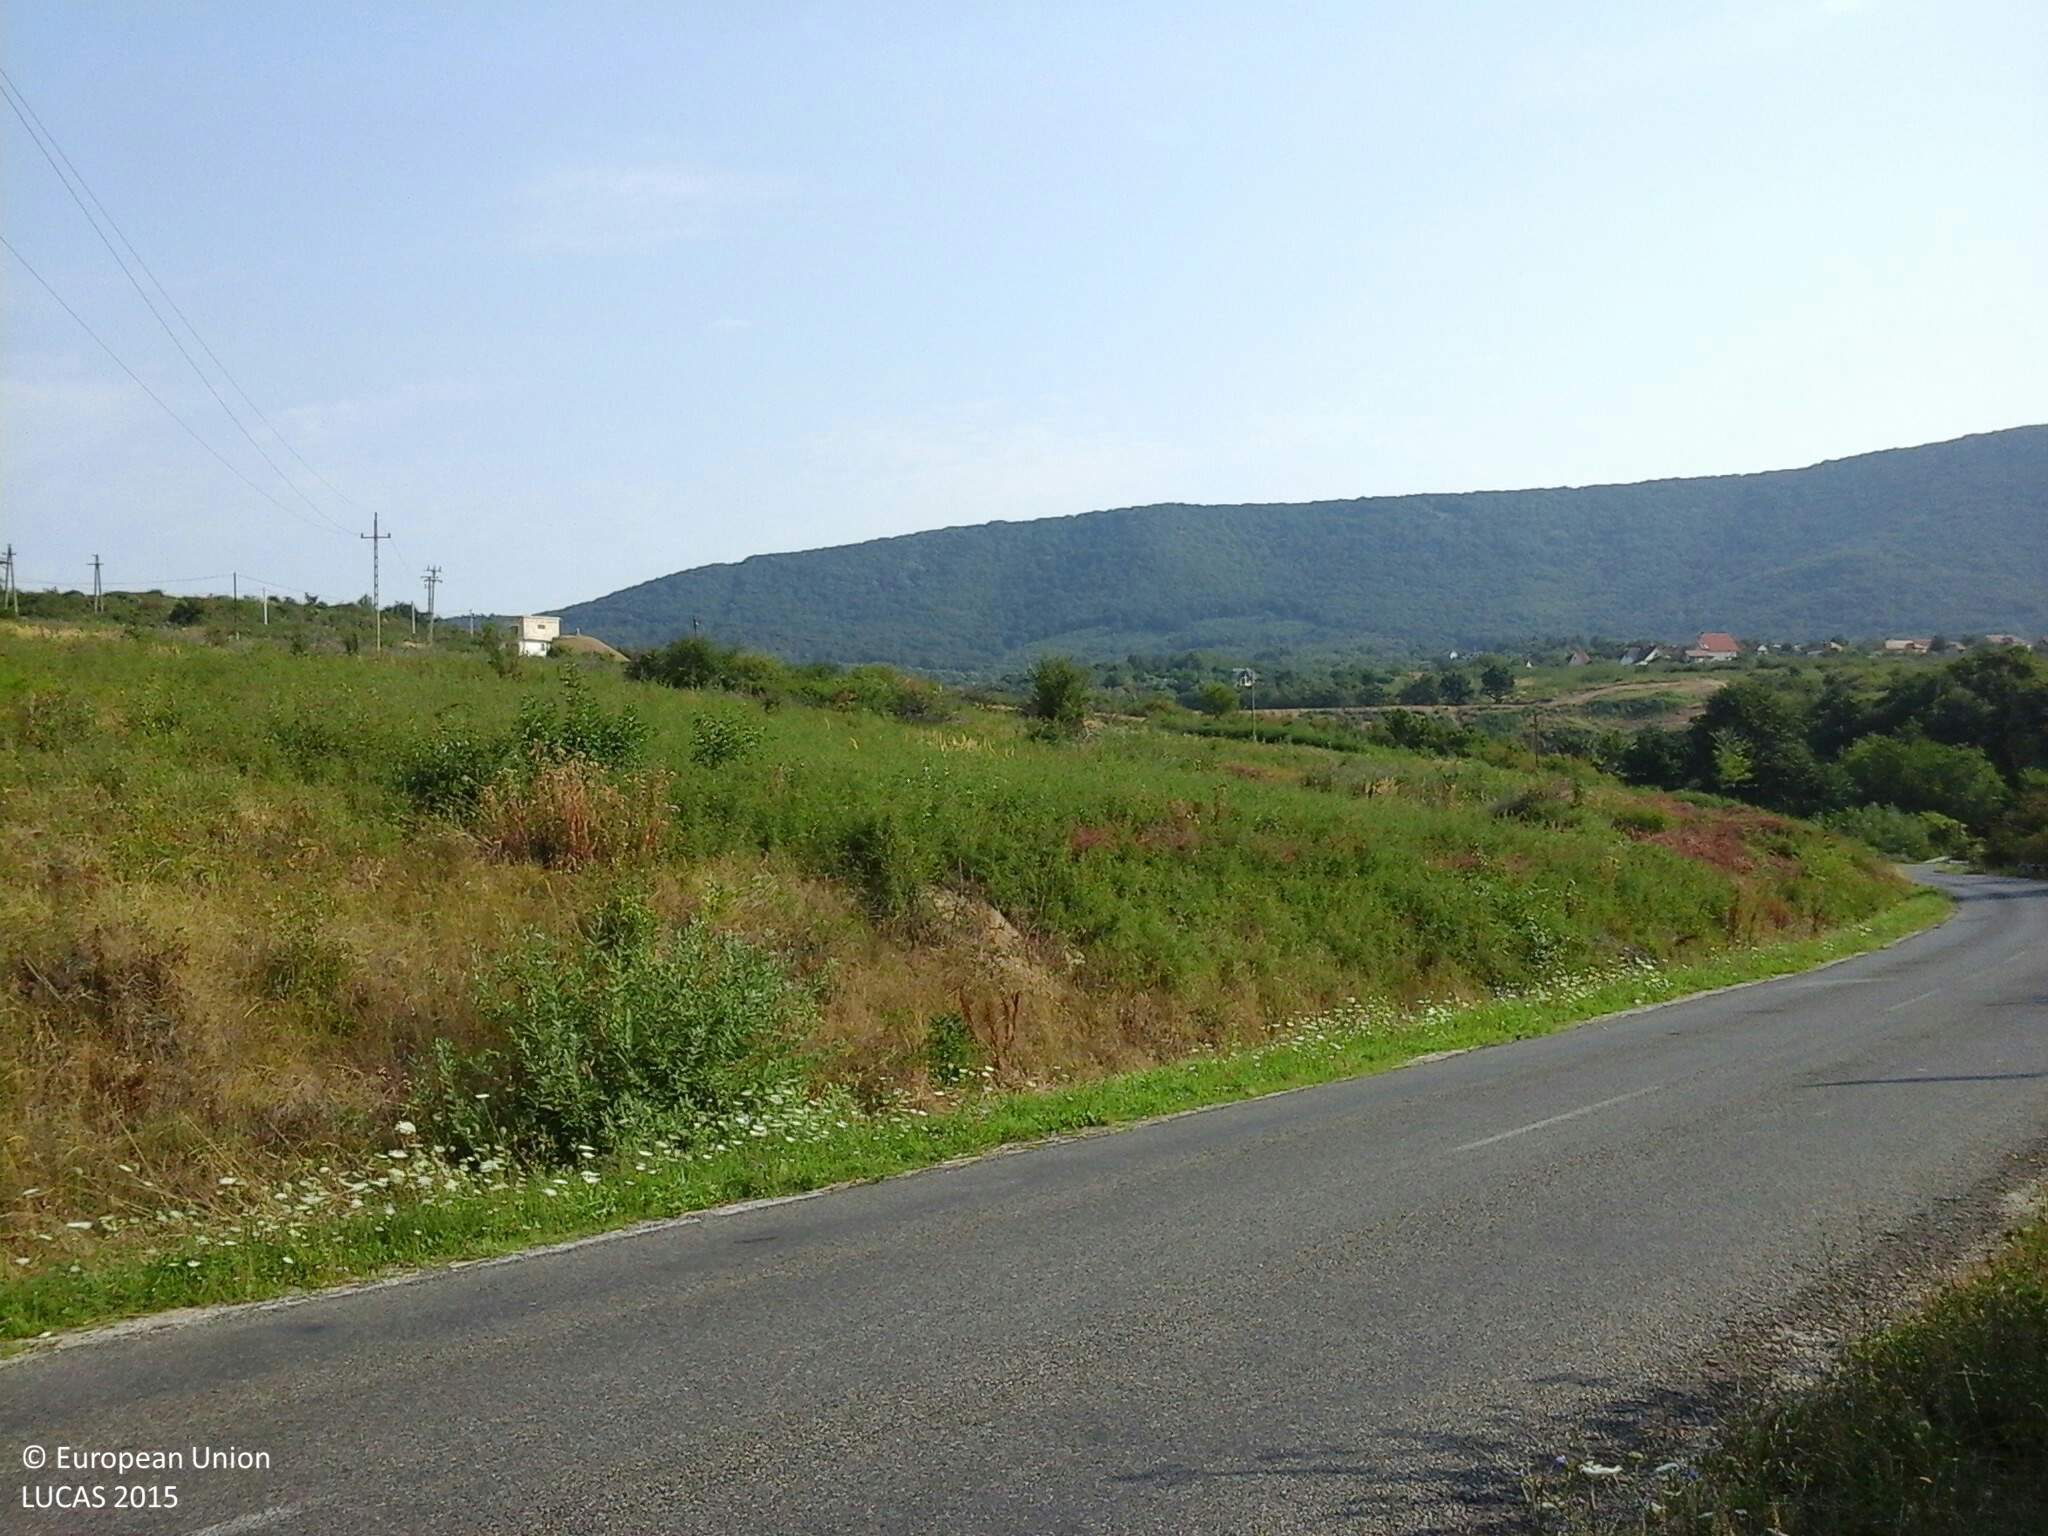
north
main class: Shrubland
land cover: Shrubland without tree cover
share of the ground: > 75 %
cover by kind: shrubs 100 %
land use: Semi-natural and natural areas not in use
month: August
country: HU
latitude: 46.0788
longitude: 18.1141
